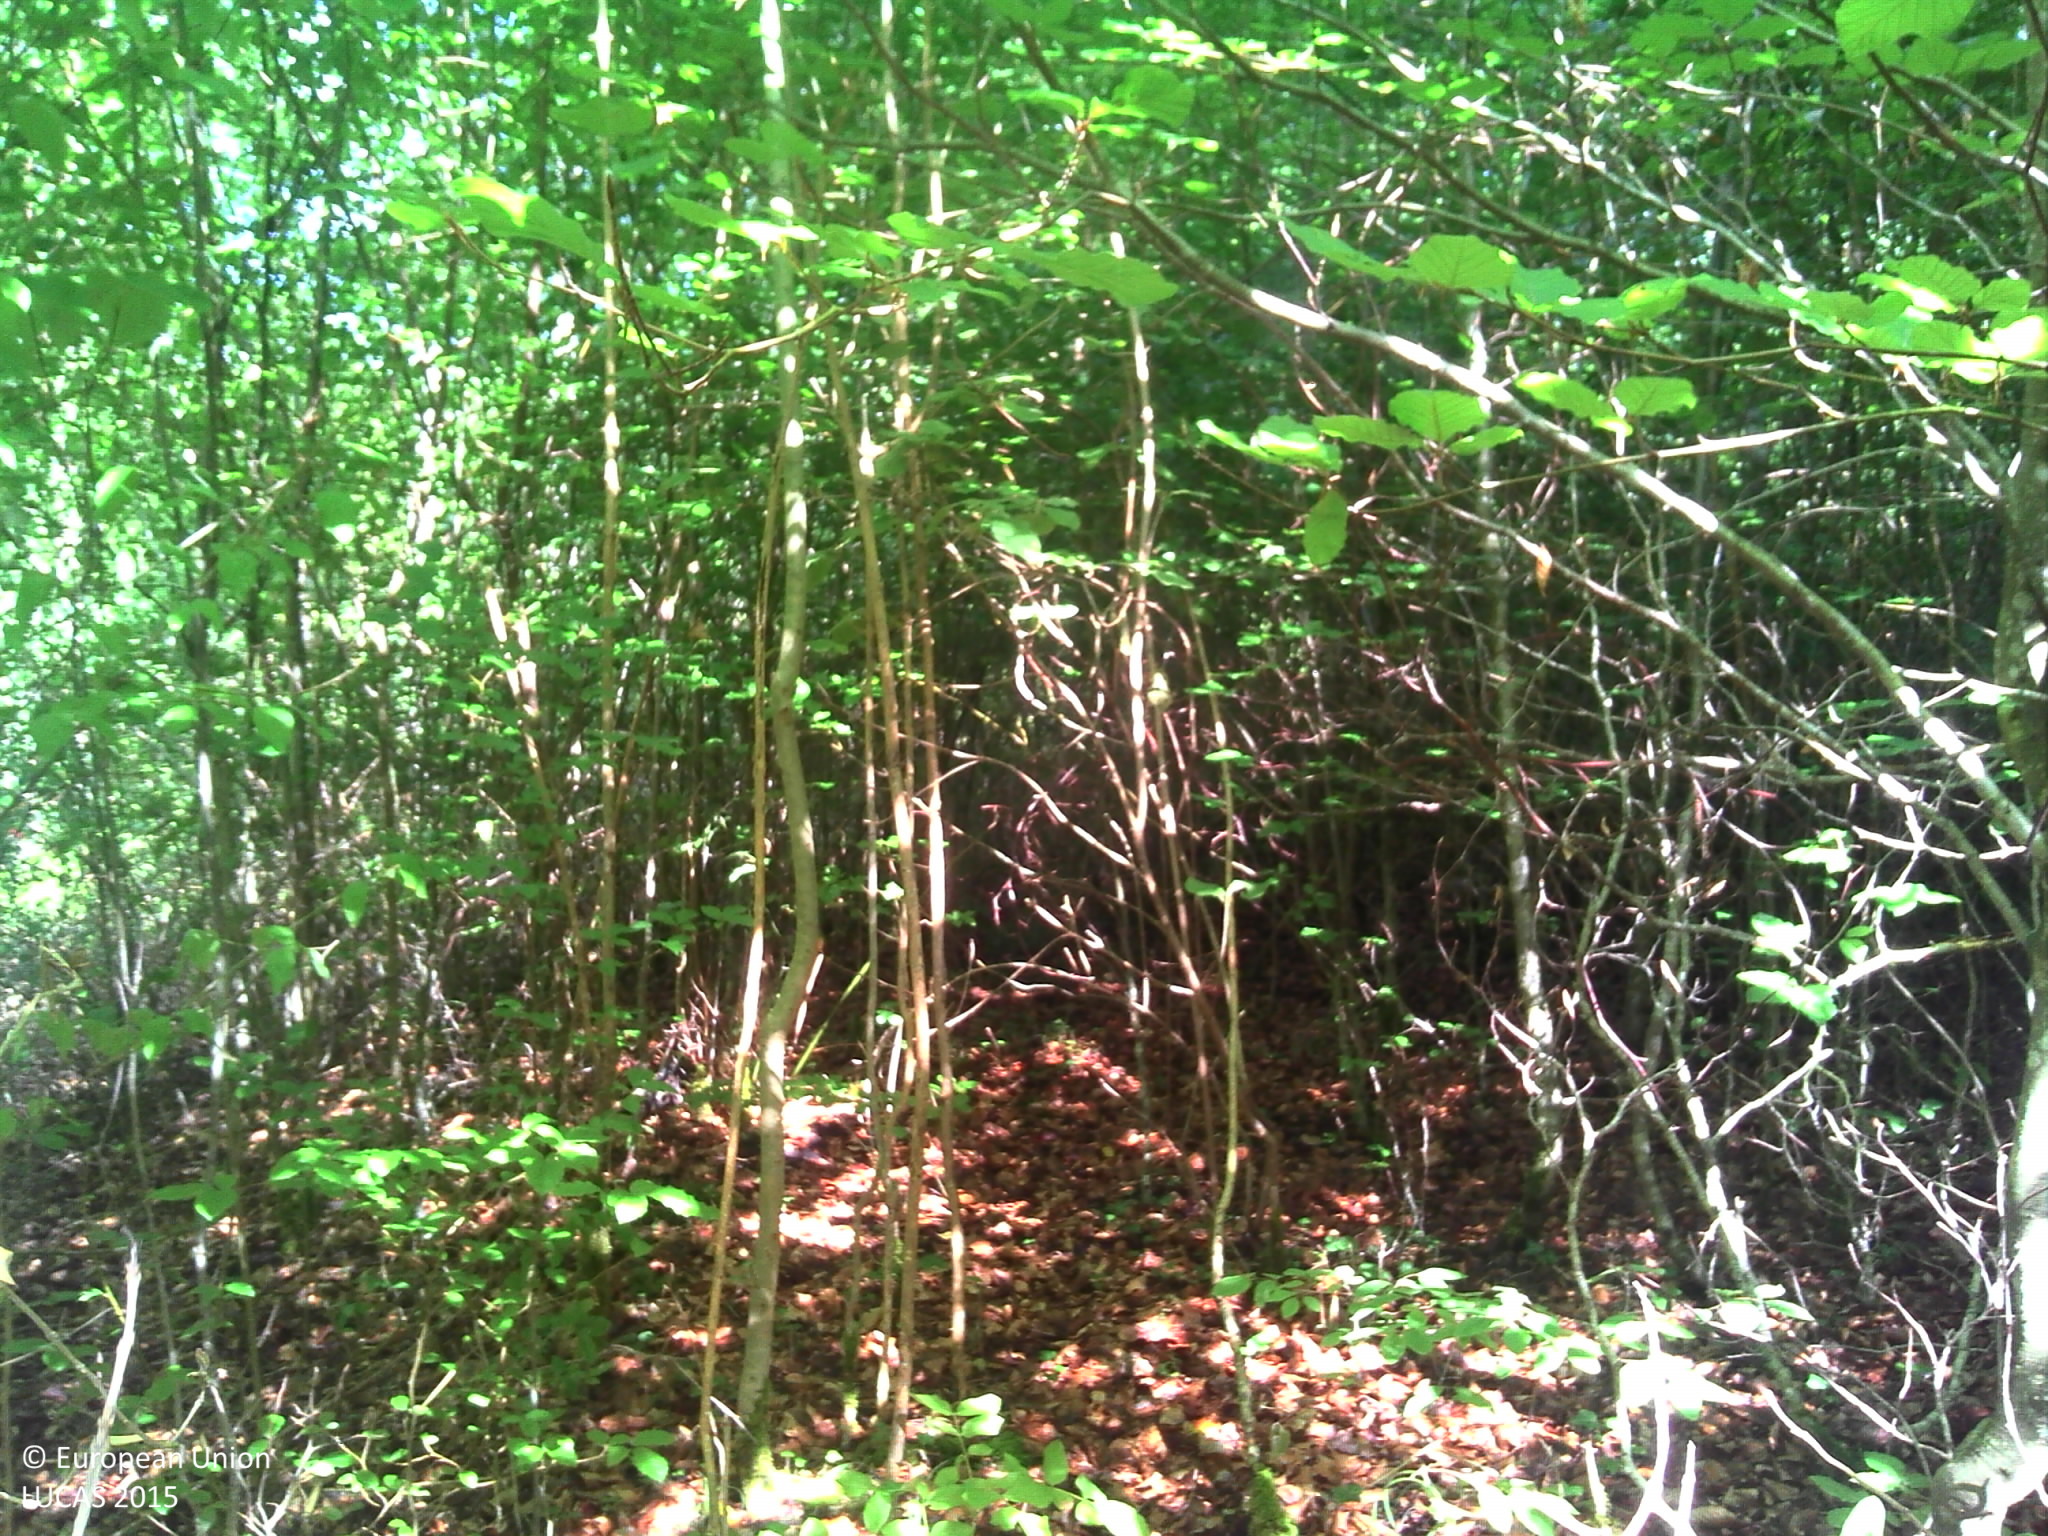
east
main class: Woodland
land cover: Broadleaved woodland
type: mesophytic deciduous forest
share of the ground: > 75 %
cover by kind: broadleaved forest trees 90 %, herbaceous plants 5 %, lichens and mosses 5 %
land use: Forestry
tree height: < 5 m
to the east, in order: Broadleaved woodland; Tracks; Broadleaved woodland; Barley
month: August
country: FR
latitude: 47.8045
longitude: 5.0191
